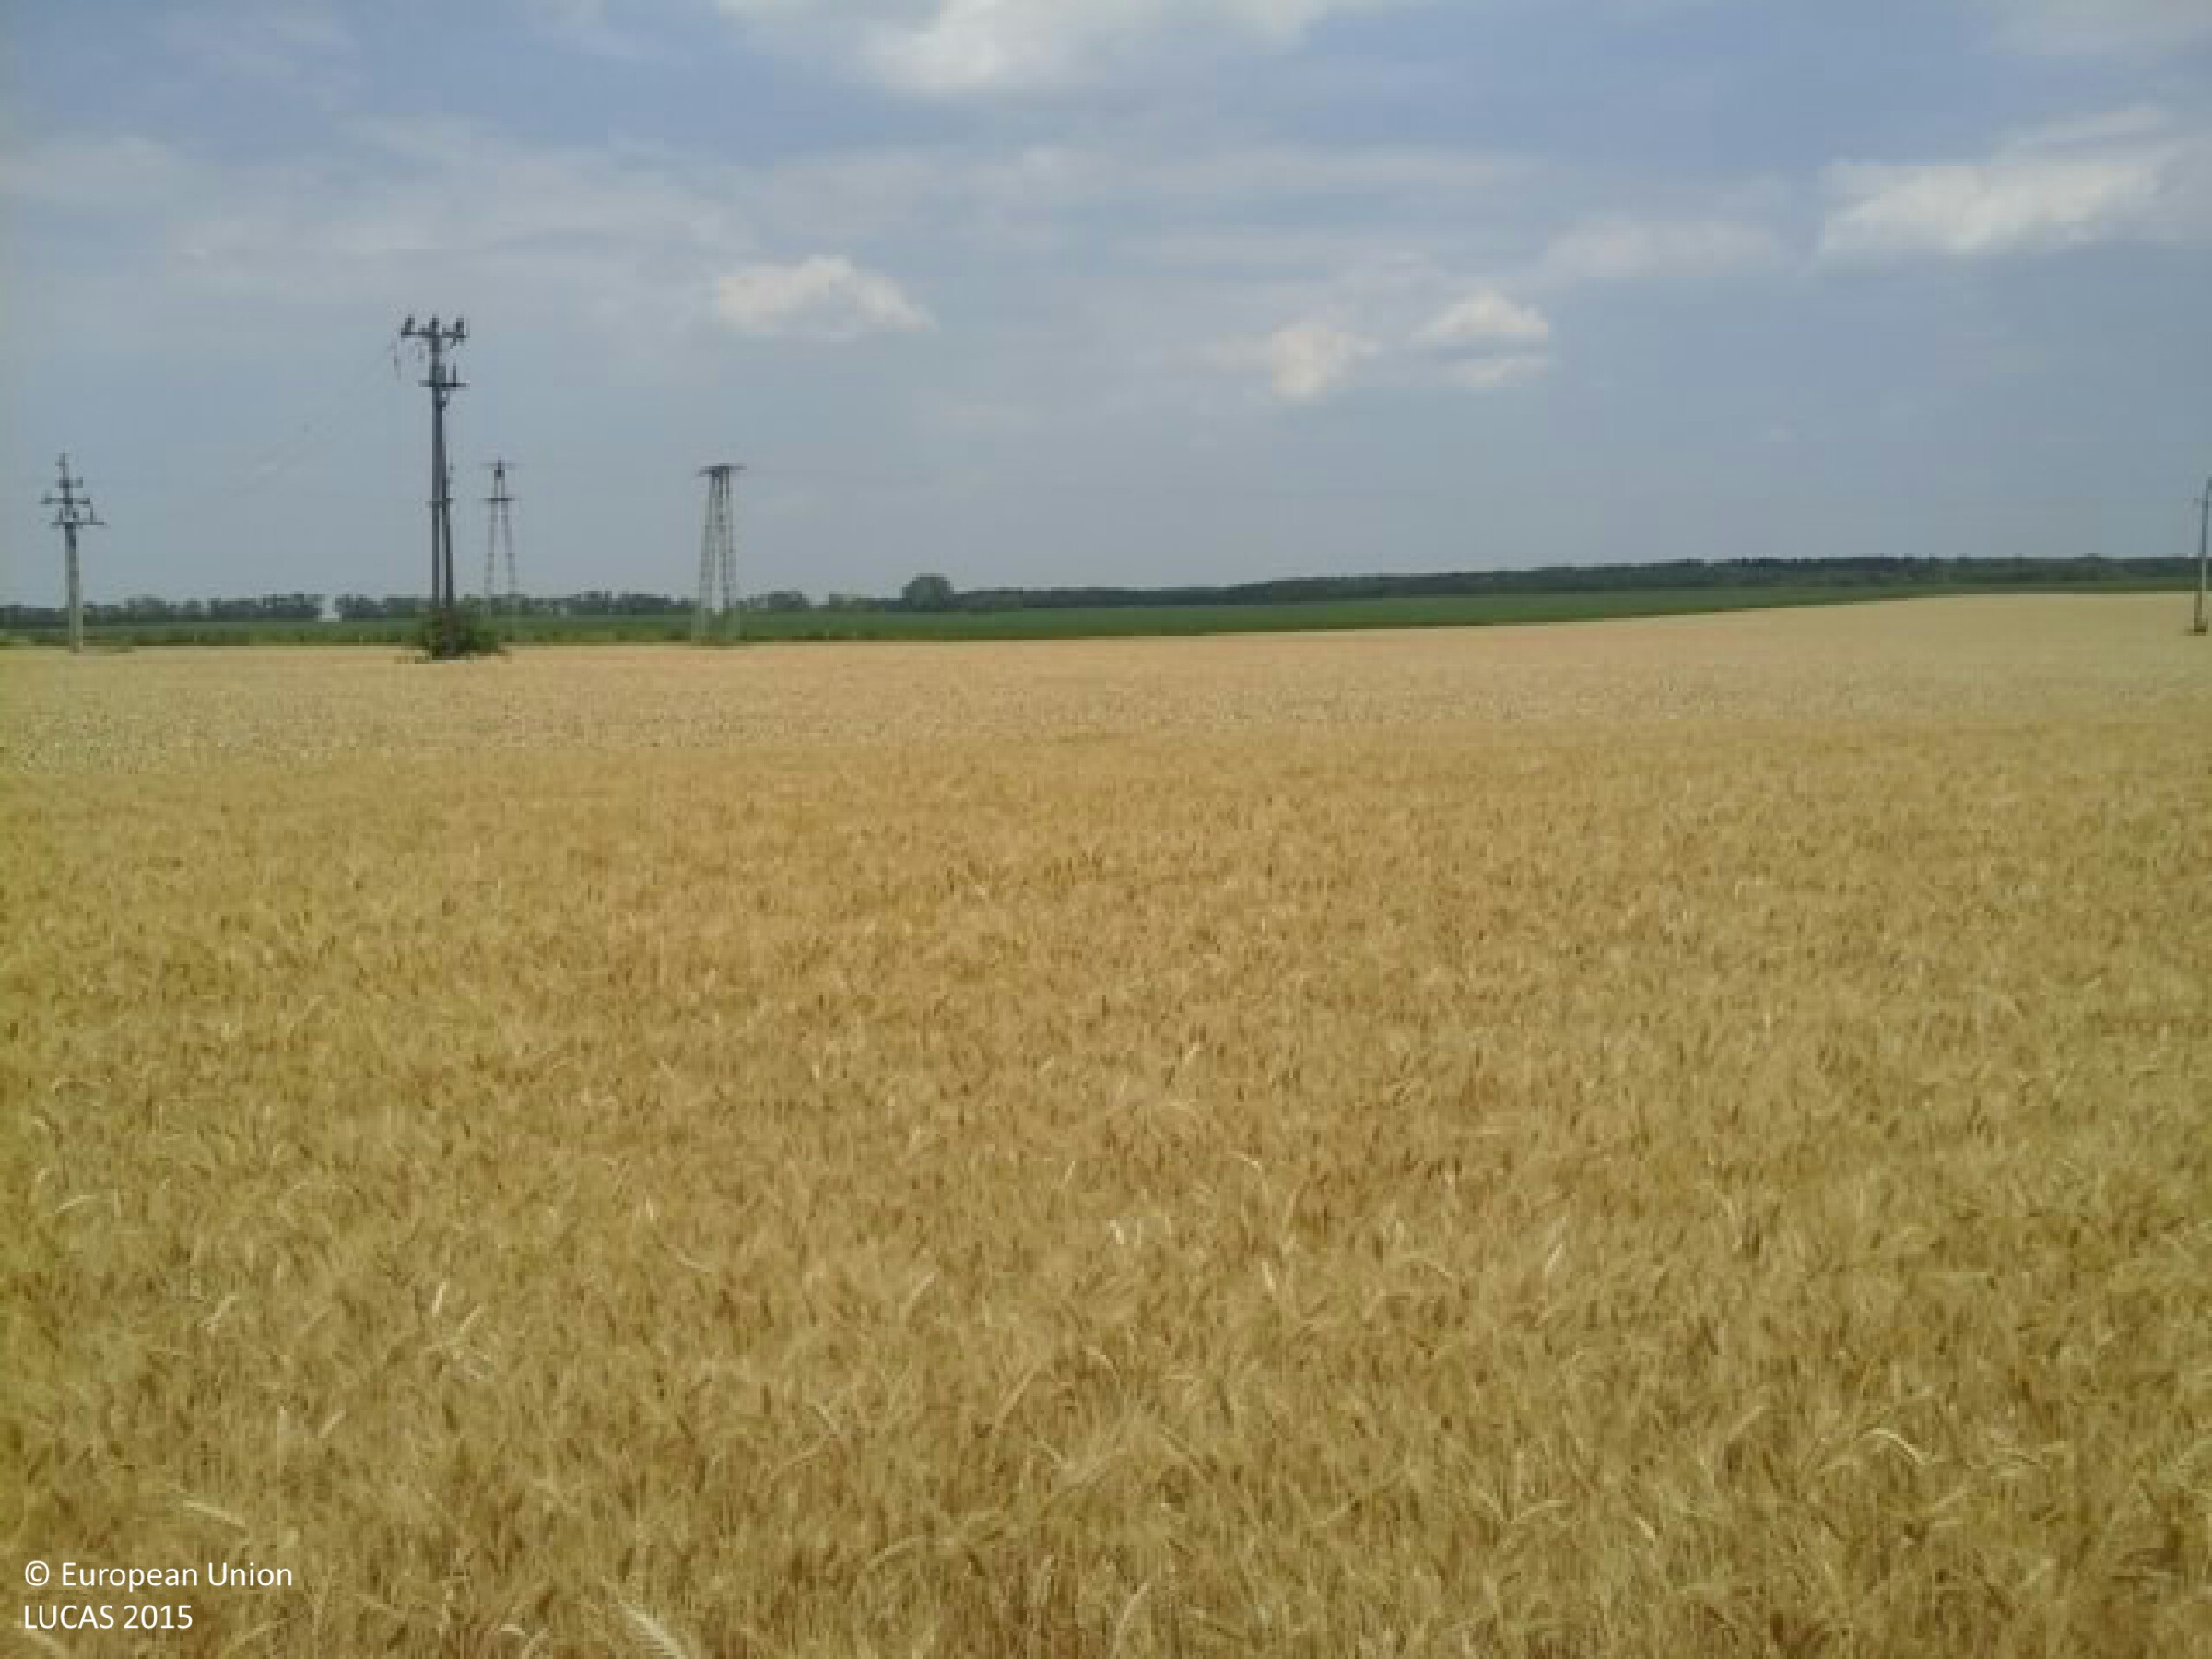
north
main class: Cropland
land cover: Common wheat
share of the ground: > 75 %
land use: Agriculture (excluding fallow land and kitchen gardens)
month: July
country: HU
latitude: 46.7403
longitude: 18.9006
